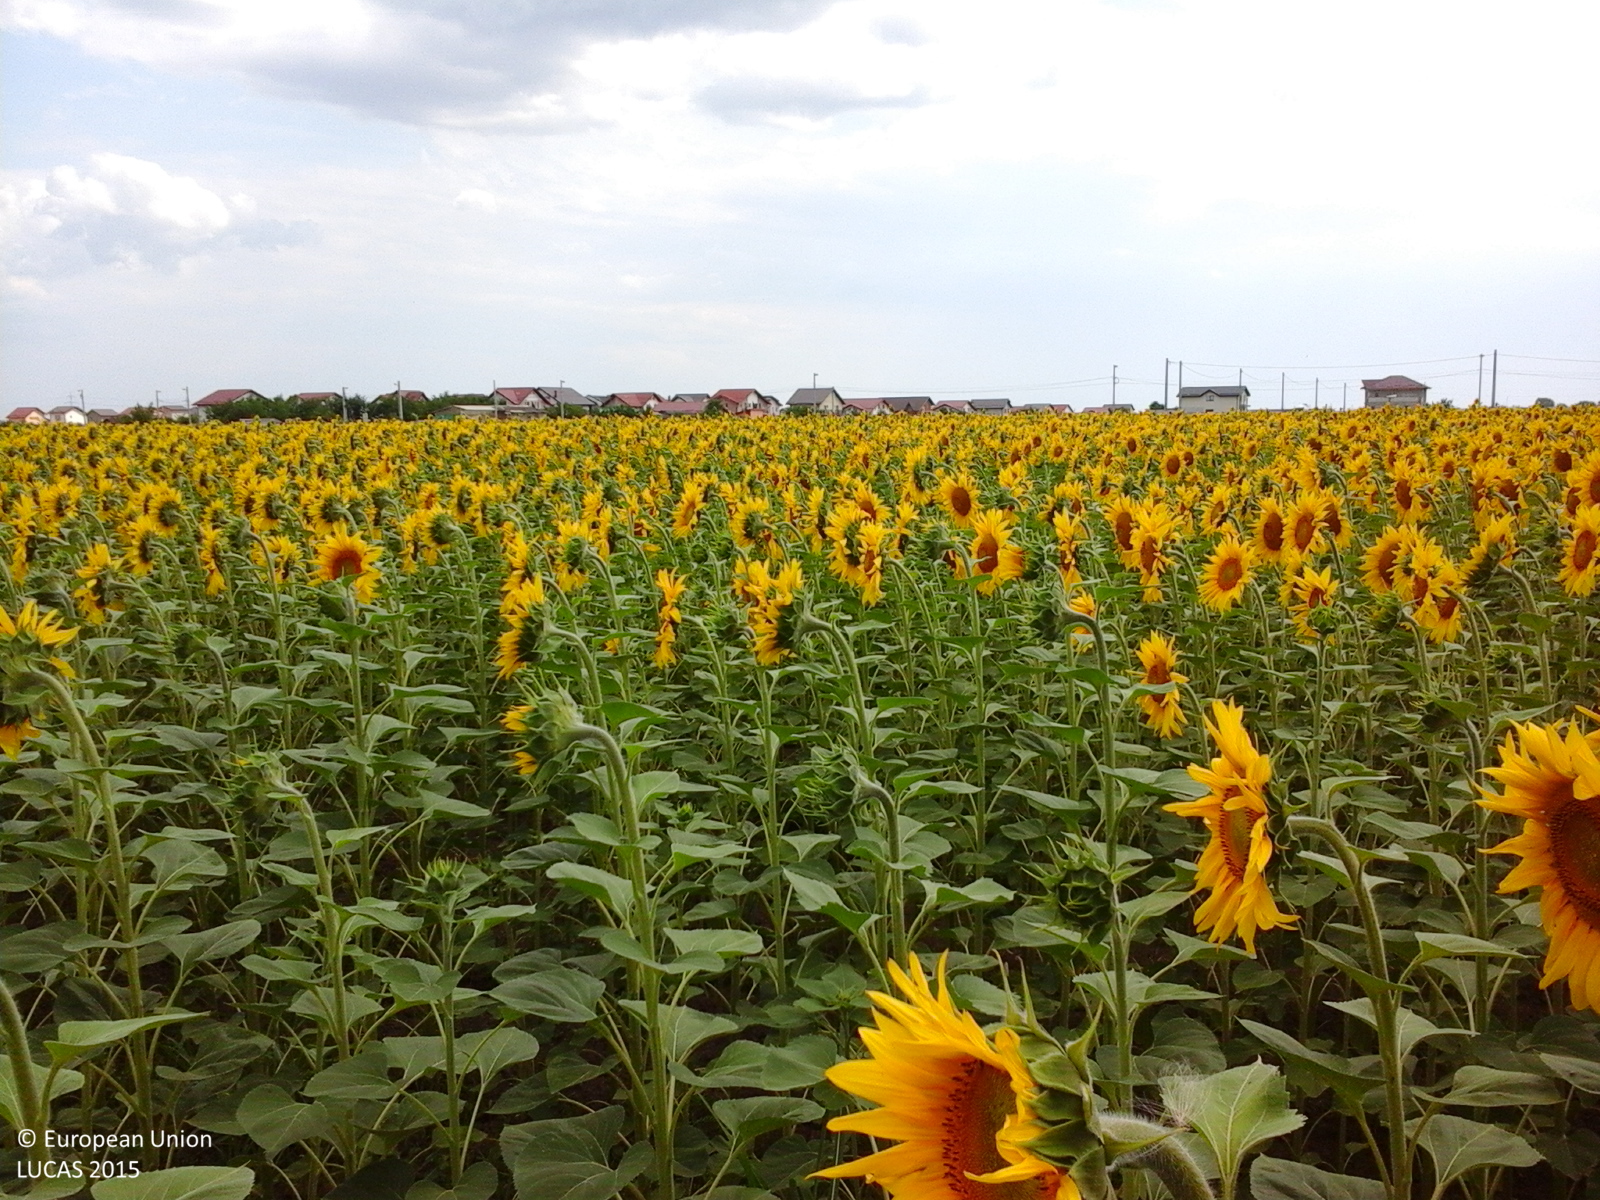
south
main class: Cropland
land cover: Sunflower
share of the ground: > 75 %
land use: Agriculture (excluding fallow land and kitchen gardens)
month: June
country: RO
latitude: 44.2824
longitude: 26.1821
